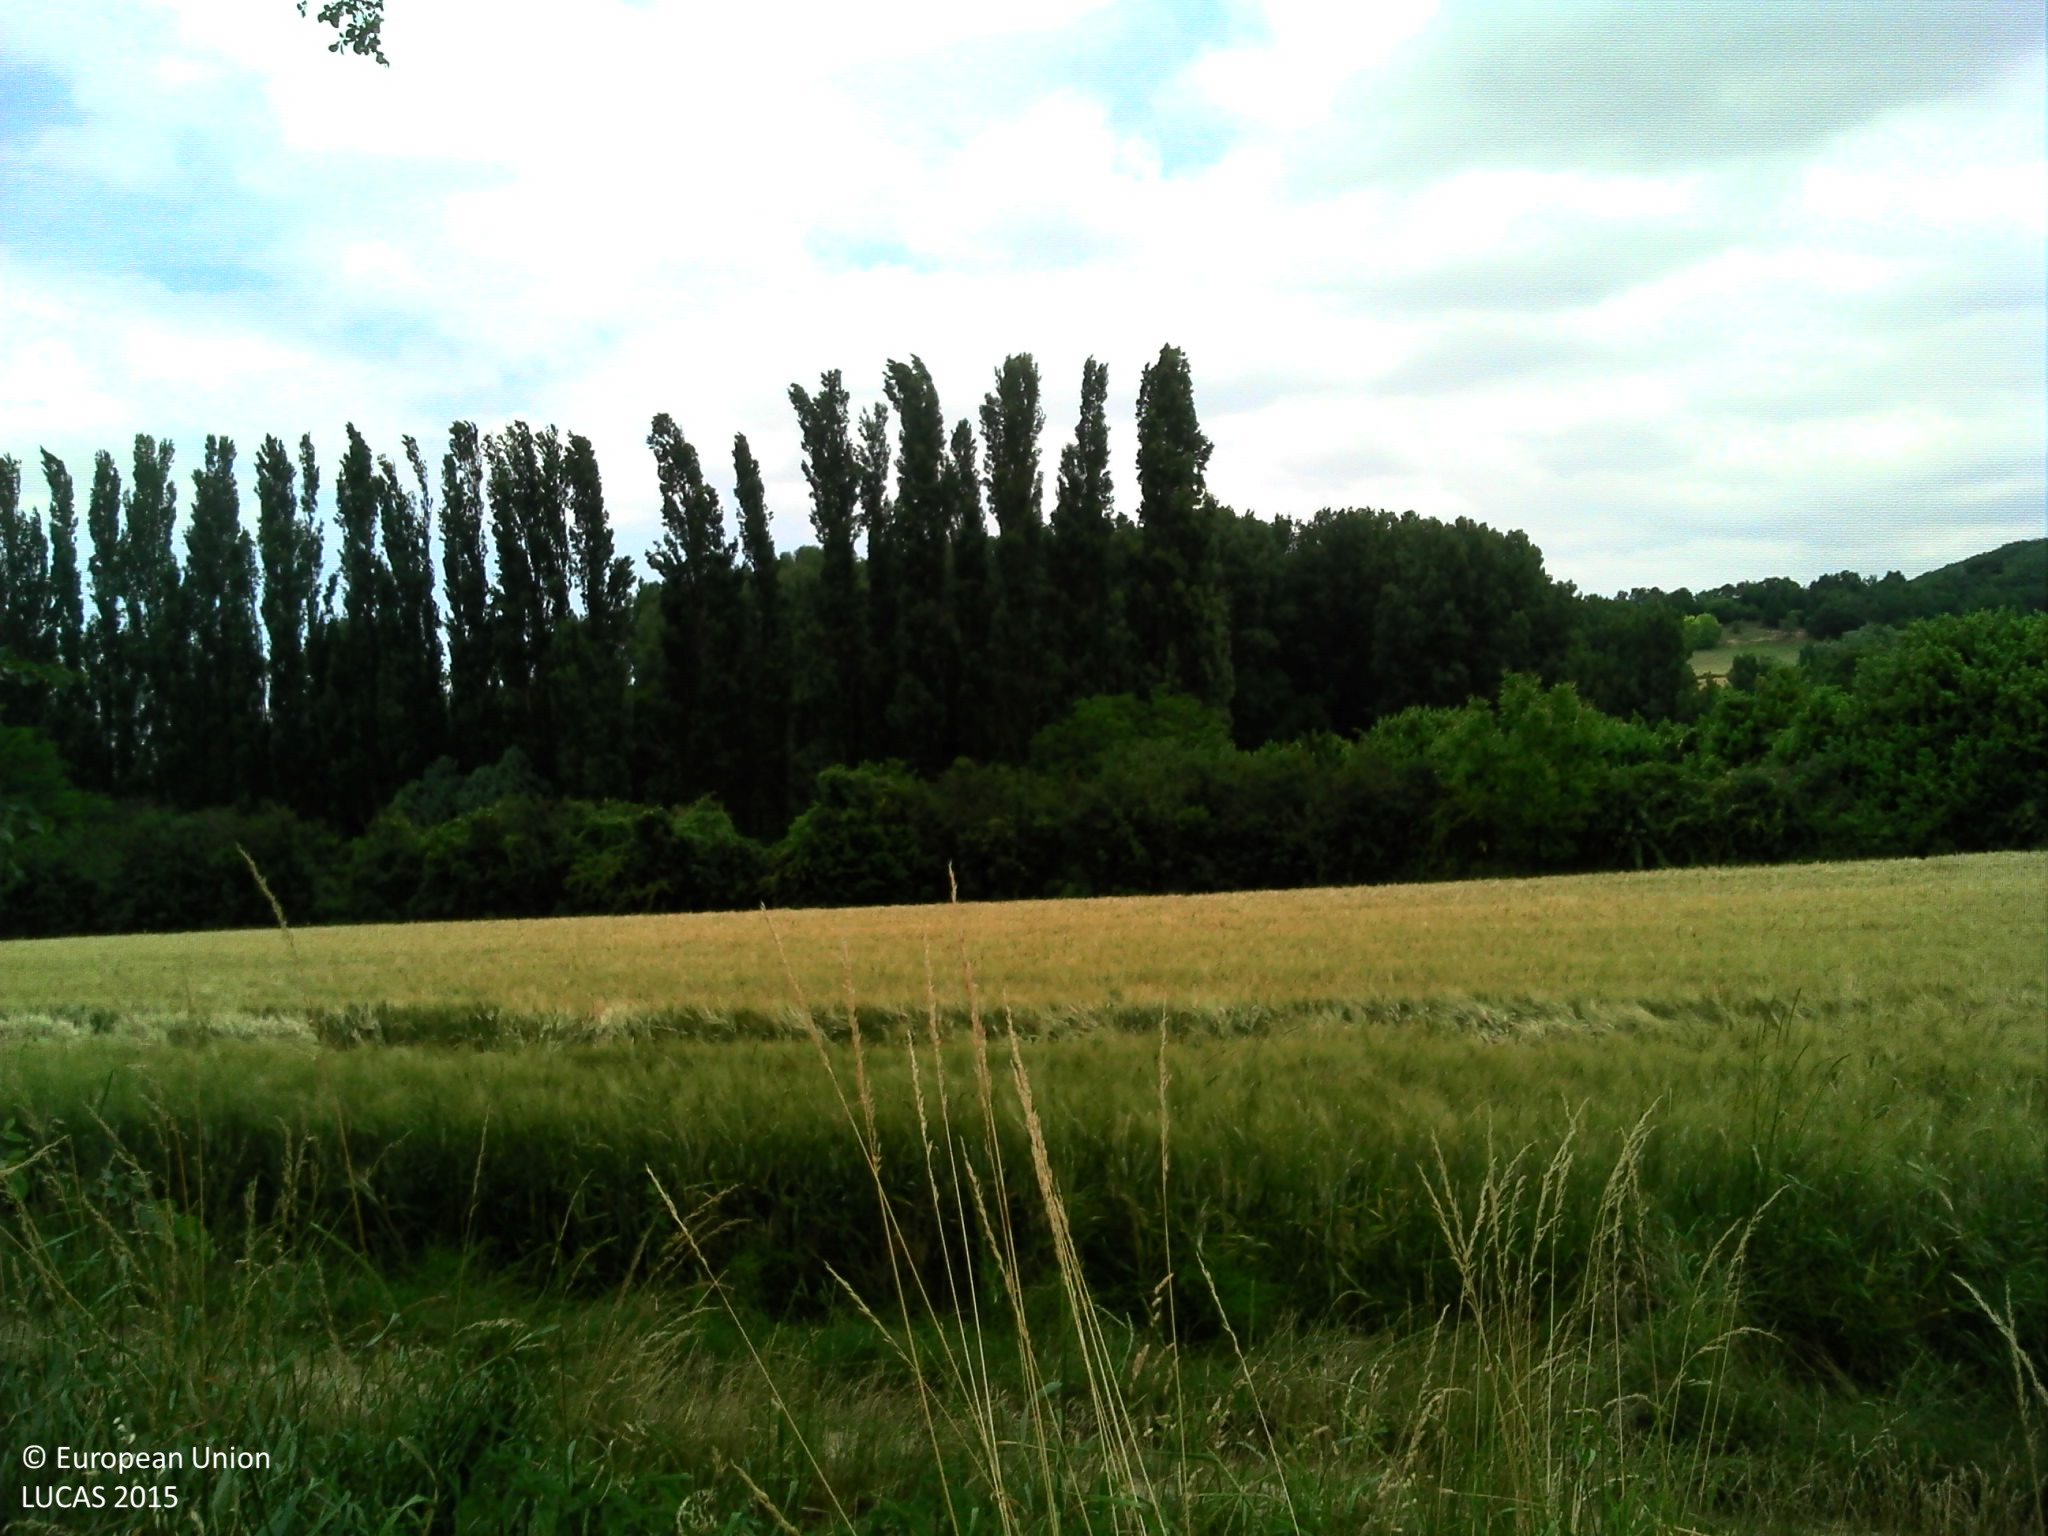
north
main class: Cropland
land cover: Barley
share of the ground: > 75 %
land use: Agriculture (excluding fallow land and kitchen gardens)
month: June
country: FR
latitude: 44.8279
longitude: 5.0354
